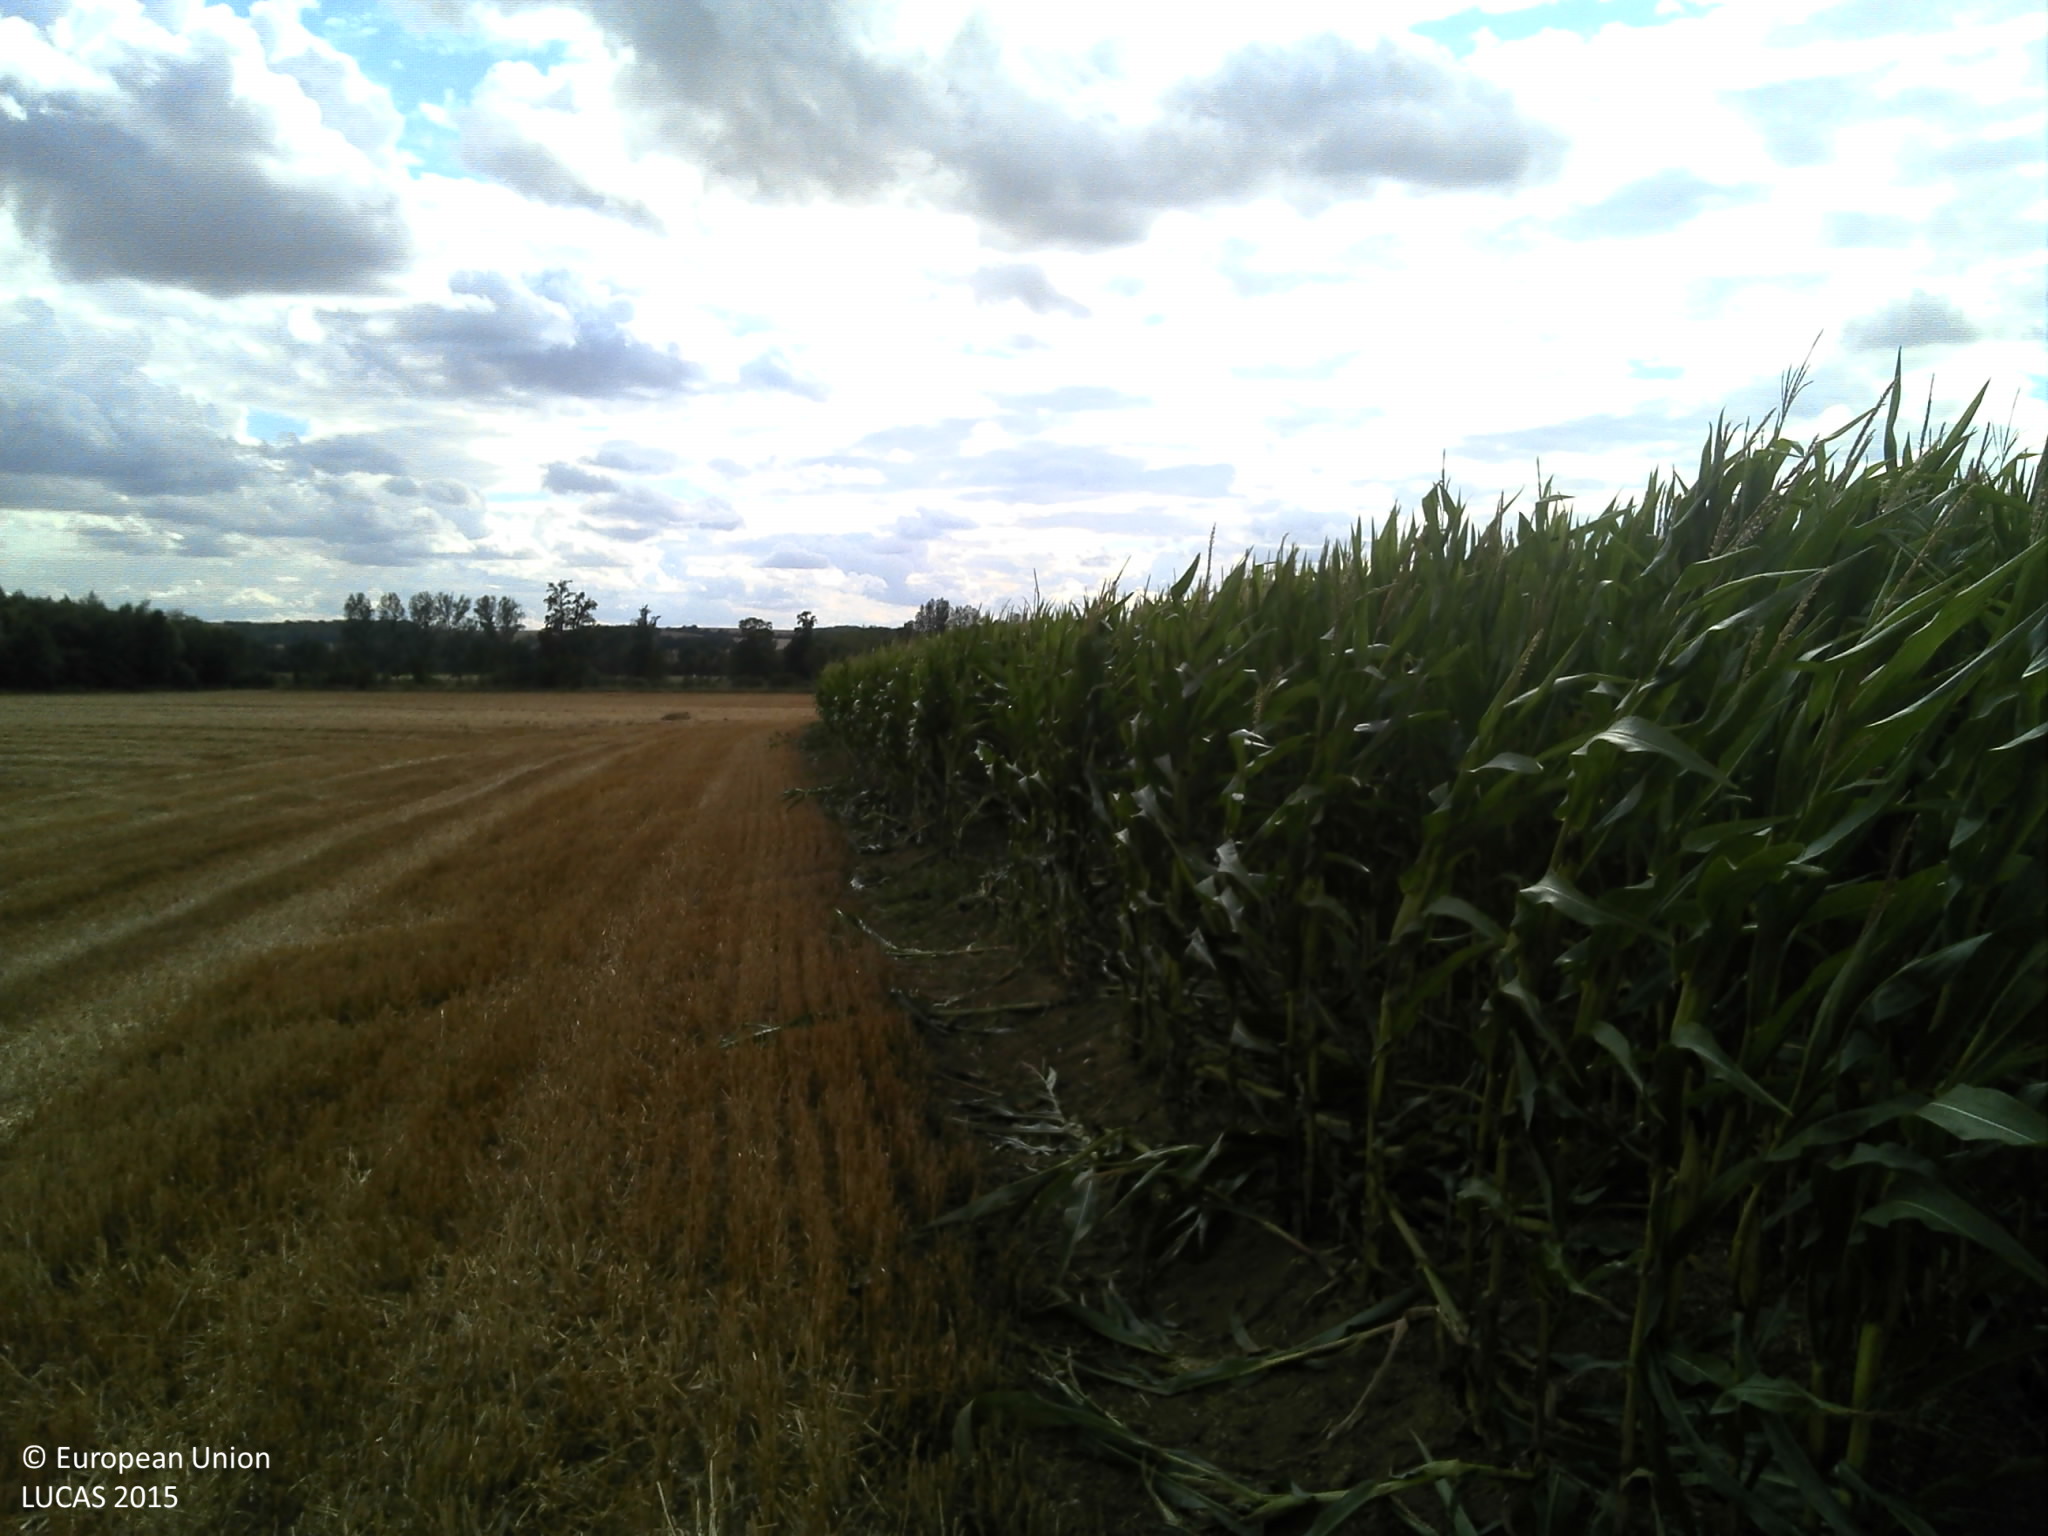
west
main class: Cropland
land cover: Maize
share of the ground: > 75 %
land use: Agriculture (excluding fallow land and kitchen gardens)
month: July
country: FR
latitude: 49.4755
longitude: 4.5173
